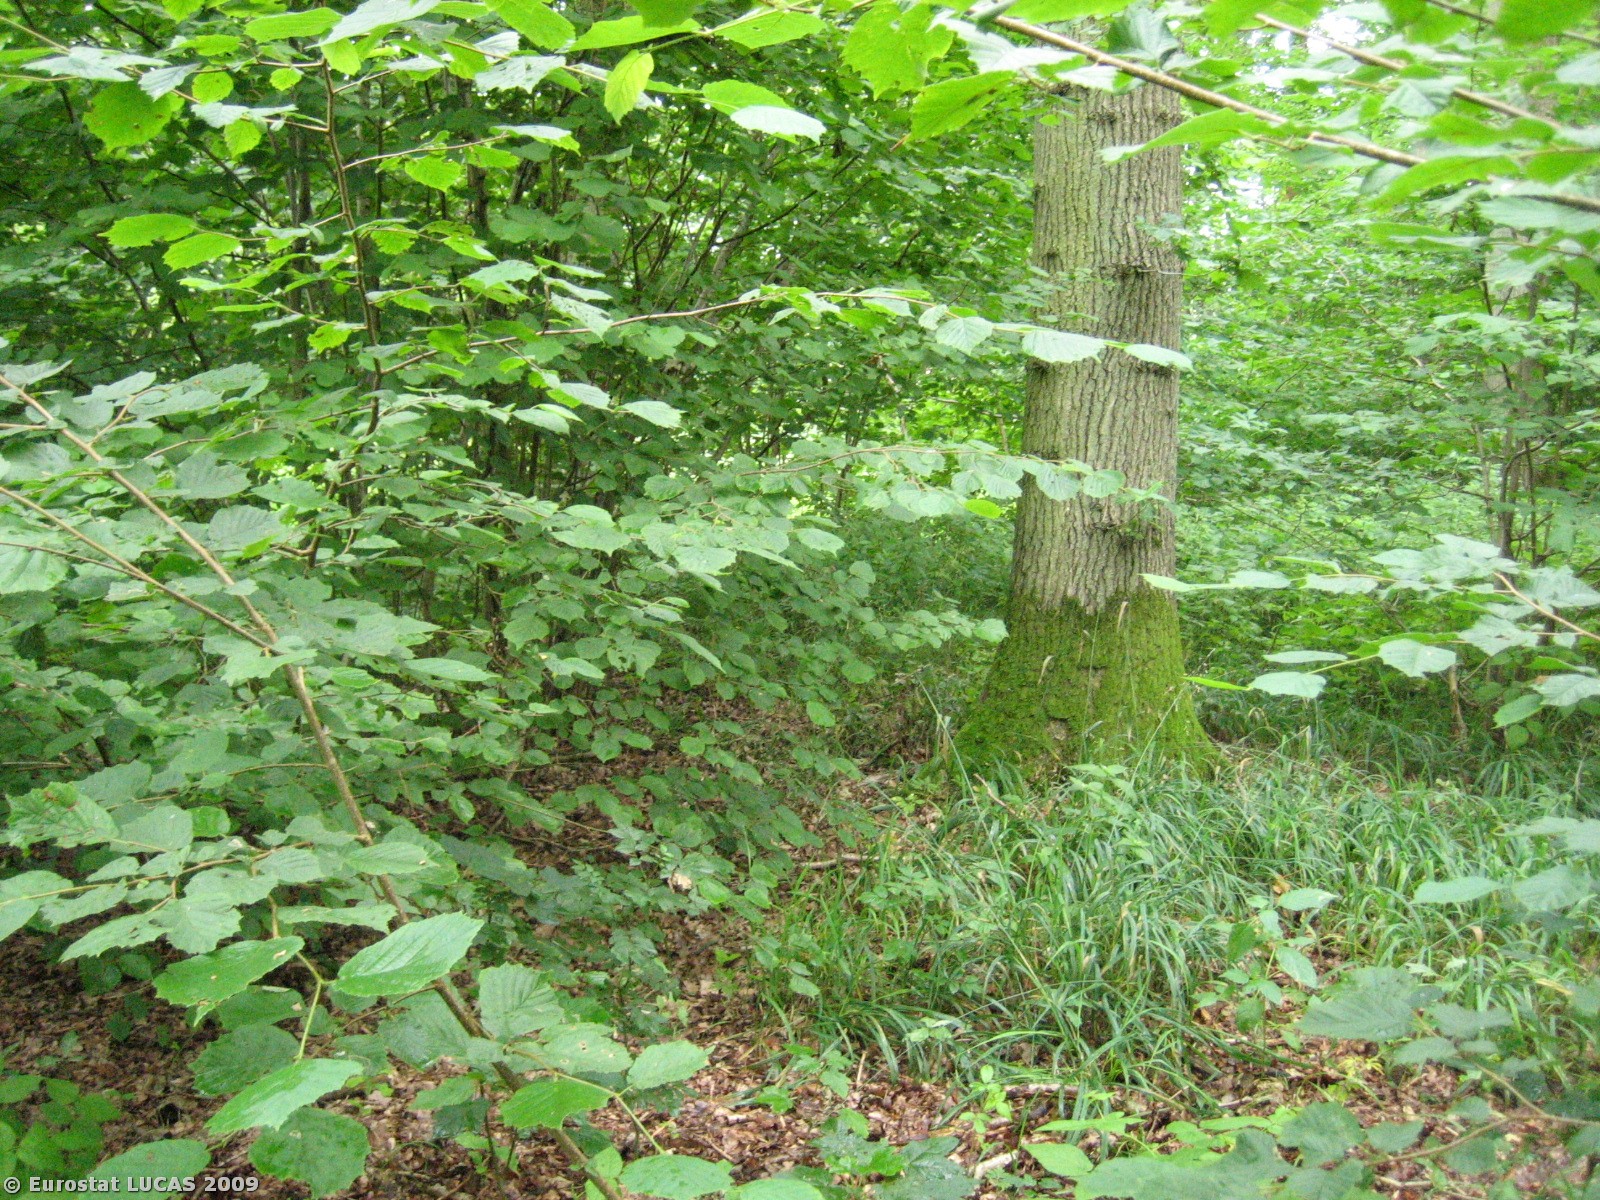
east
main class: Woodland
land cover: Broadleaved woodland
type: mesophytic deciduous forest
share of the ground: > 75 %
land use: Forestry
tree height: > 5 m
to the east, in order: Broadleaved woodland; Grassland without tree/shrub cover; Grass margins; Rape and turnip rape
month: July
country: DK
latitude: 55.3609
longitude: 9.9212
